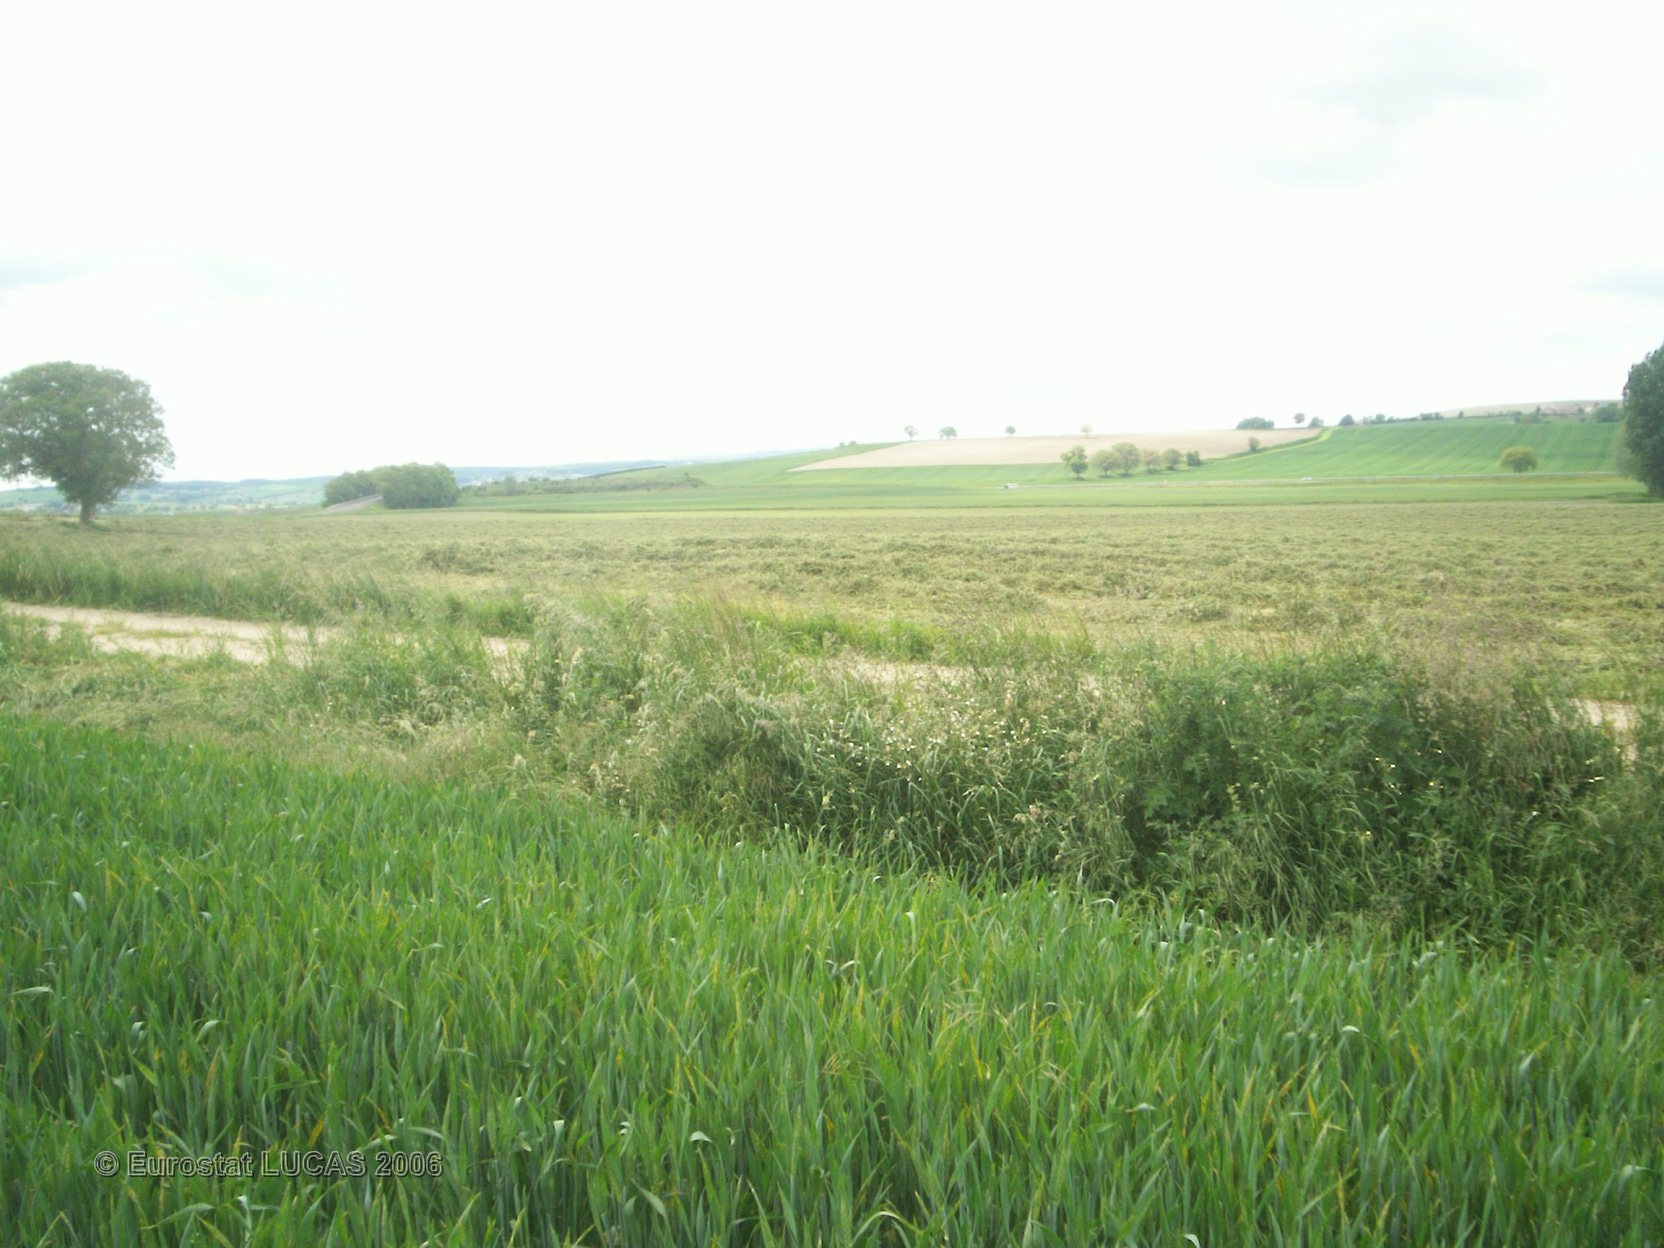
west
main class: Cropland
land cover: Common wheat
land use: Agriculture (excluding fallow land and kitchen gardens)
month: May
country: FR
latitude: 46.1479
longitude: 3.1238
